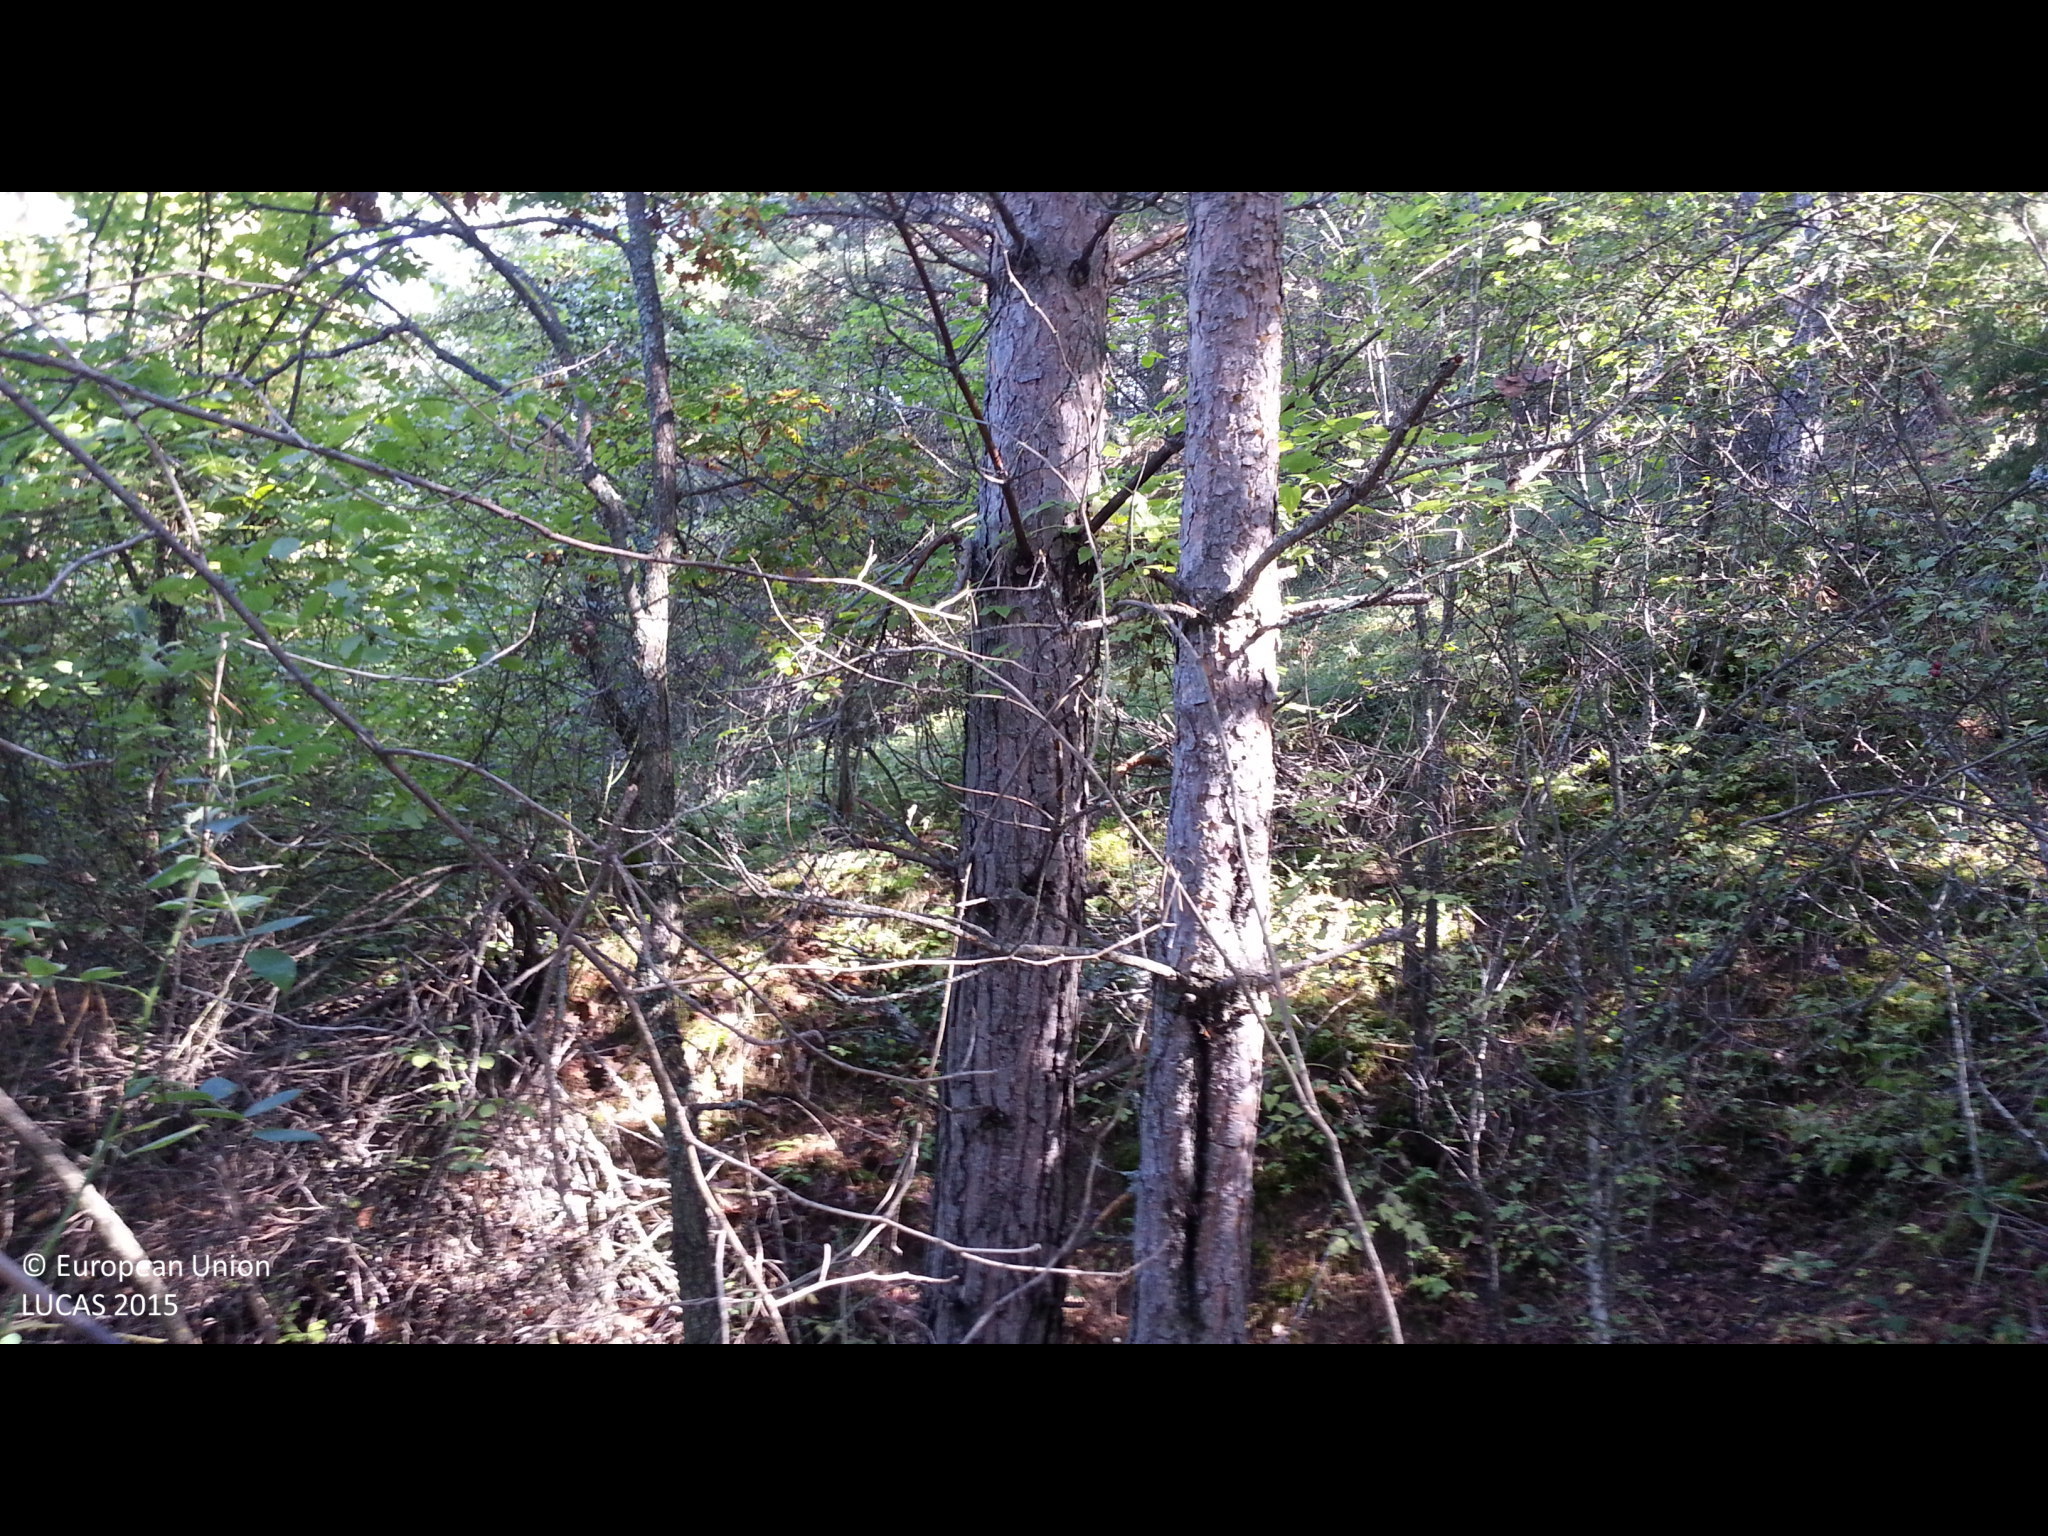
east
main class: Woodland
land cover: Other mixed woodland
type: hemiboreal forest and nemoral coniferous forest and mixed broadleaved-coniferous forest
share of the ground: > 75 %
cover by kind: coniferous forest trees 40 %, broadleaved forest trees 40 %, unconsolidated bare surface 10 %, shrubs 5 %, herbaceous plants 5 %
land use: Forestry
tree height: > 5 m
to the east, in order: Other mixed woodland; Broadleaved woodland; Pine dominated mixed woodland; Grassland with sparse tree/shrub cover
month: October
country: BG
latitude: 42.6843
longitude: 22.6073
